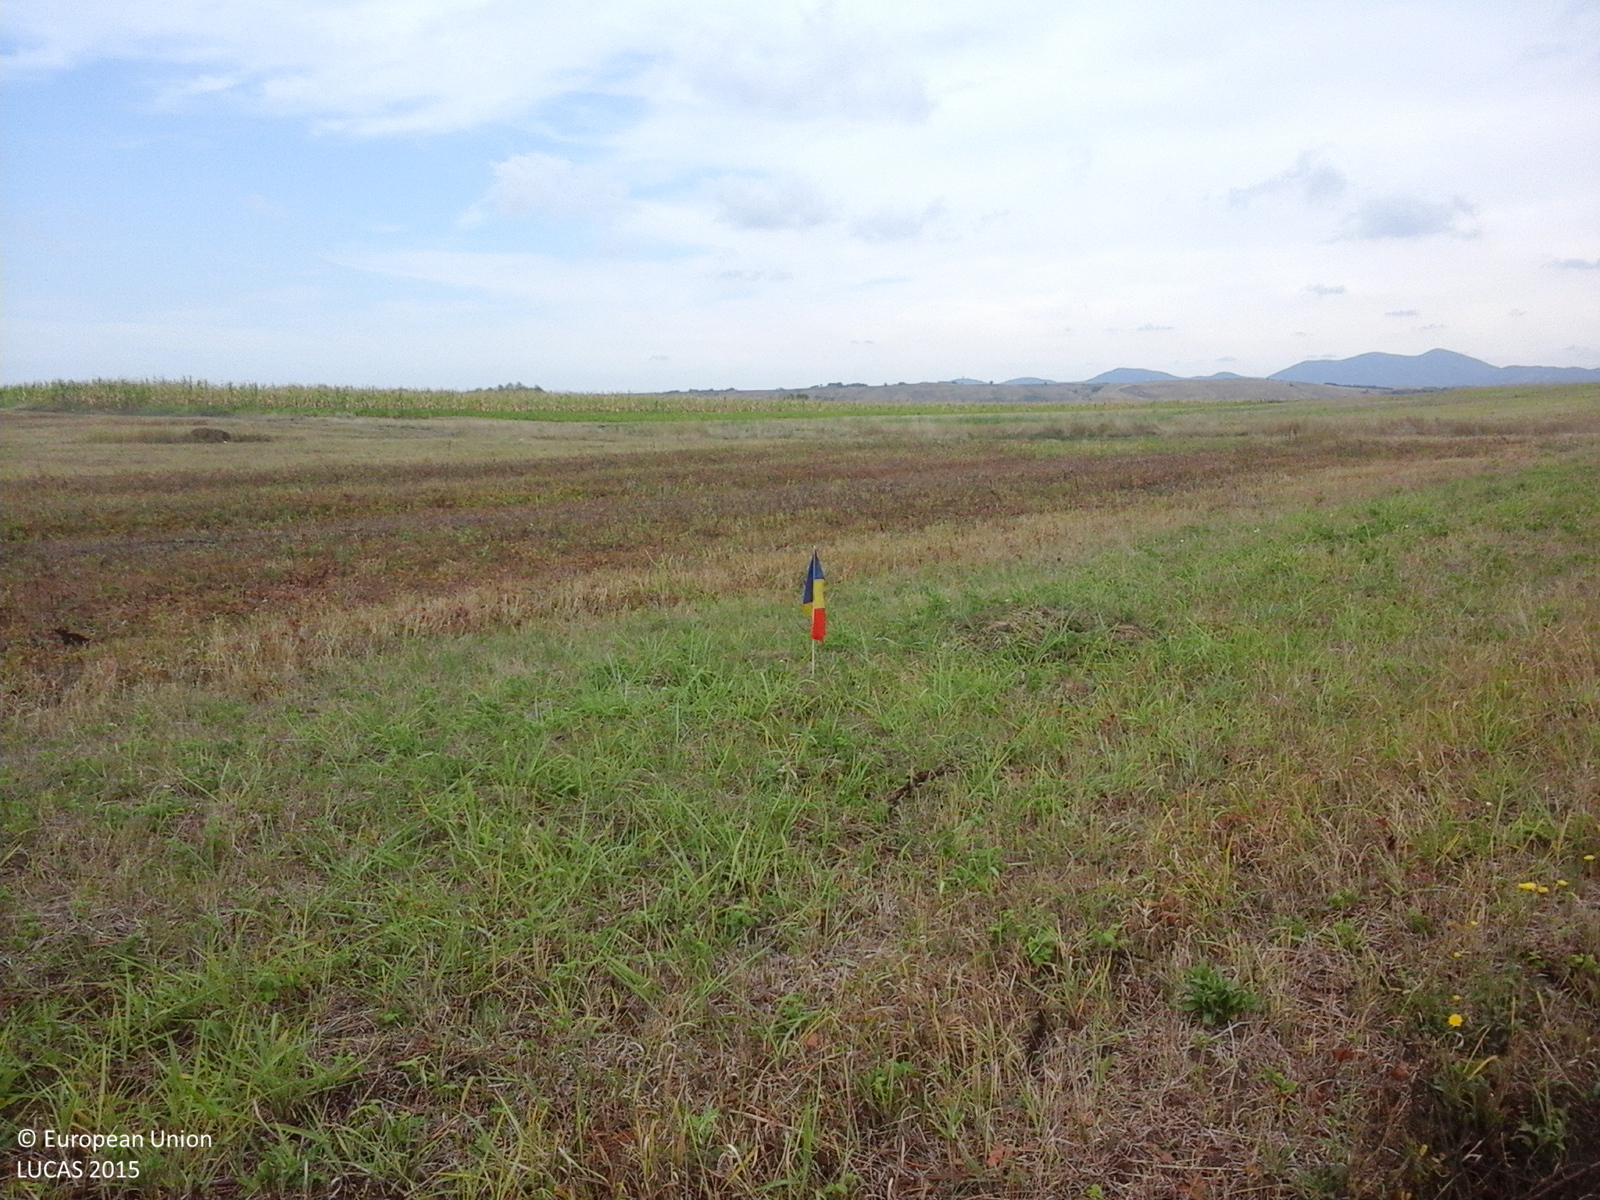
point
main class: Grassland
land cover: Grassland without tree/shrub cover
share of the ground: > 75 %
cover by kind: herbaceous plants 100 %
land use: Agriculture (excluding fallow land and kitchen gardens)
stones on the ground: < 10 %
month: August
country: RO
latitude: 45.0110
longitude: 21.4096
